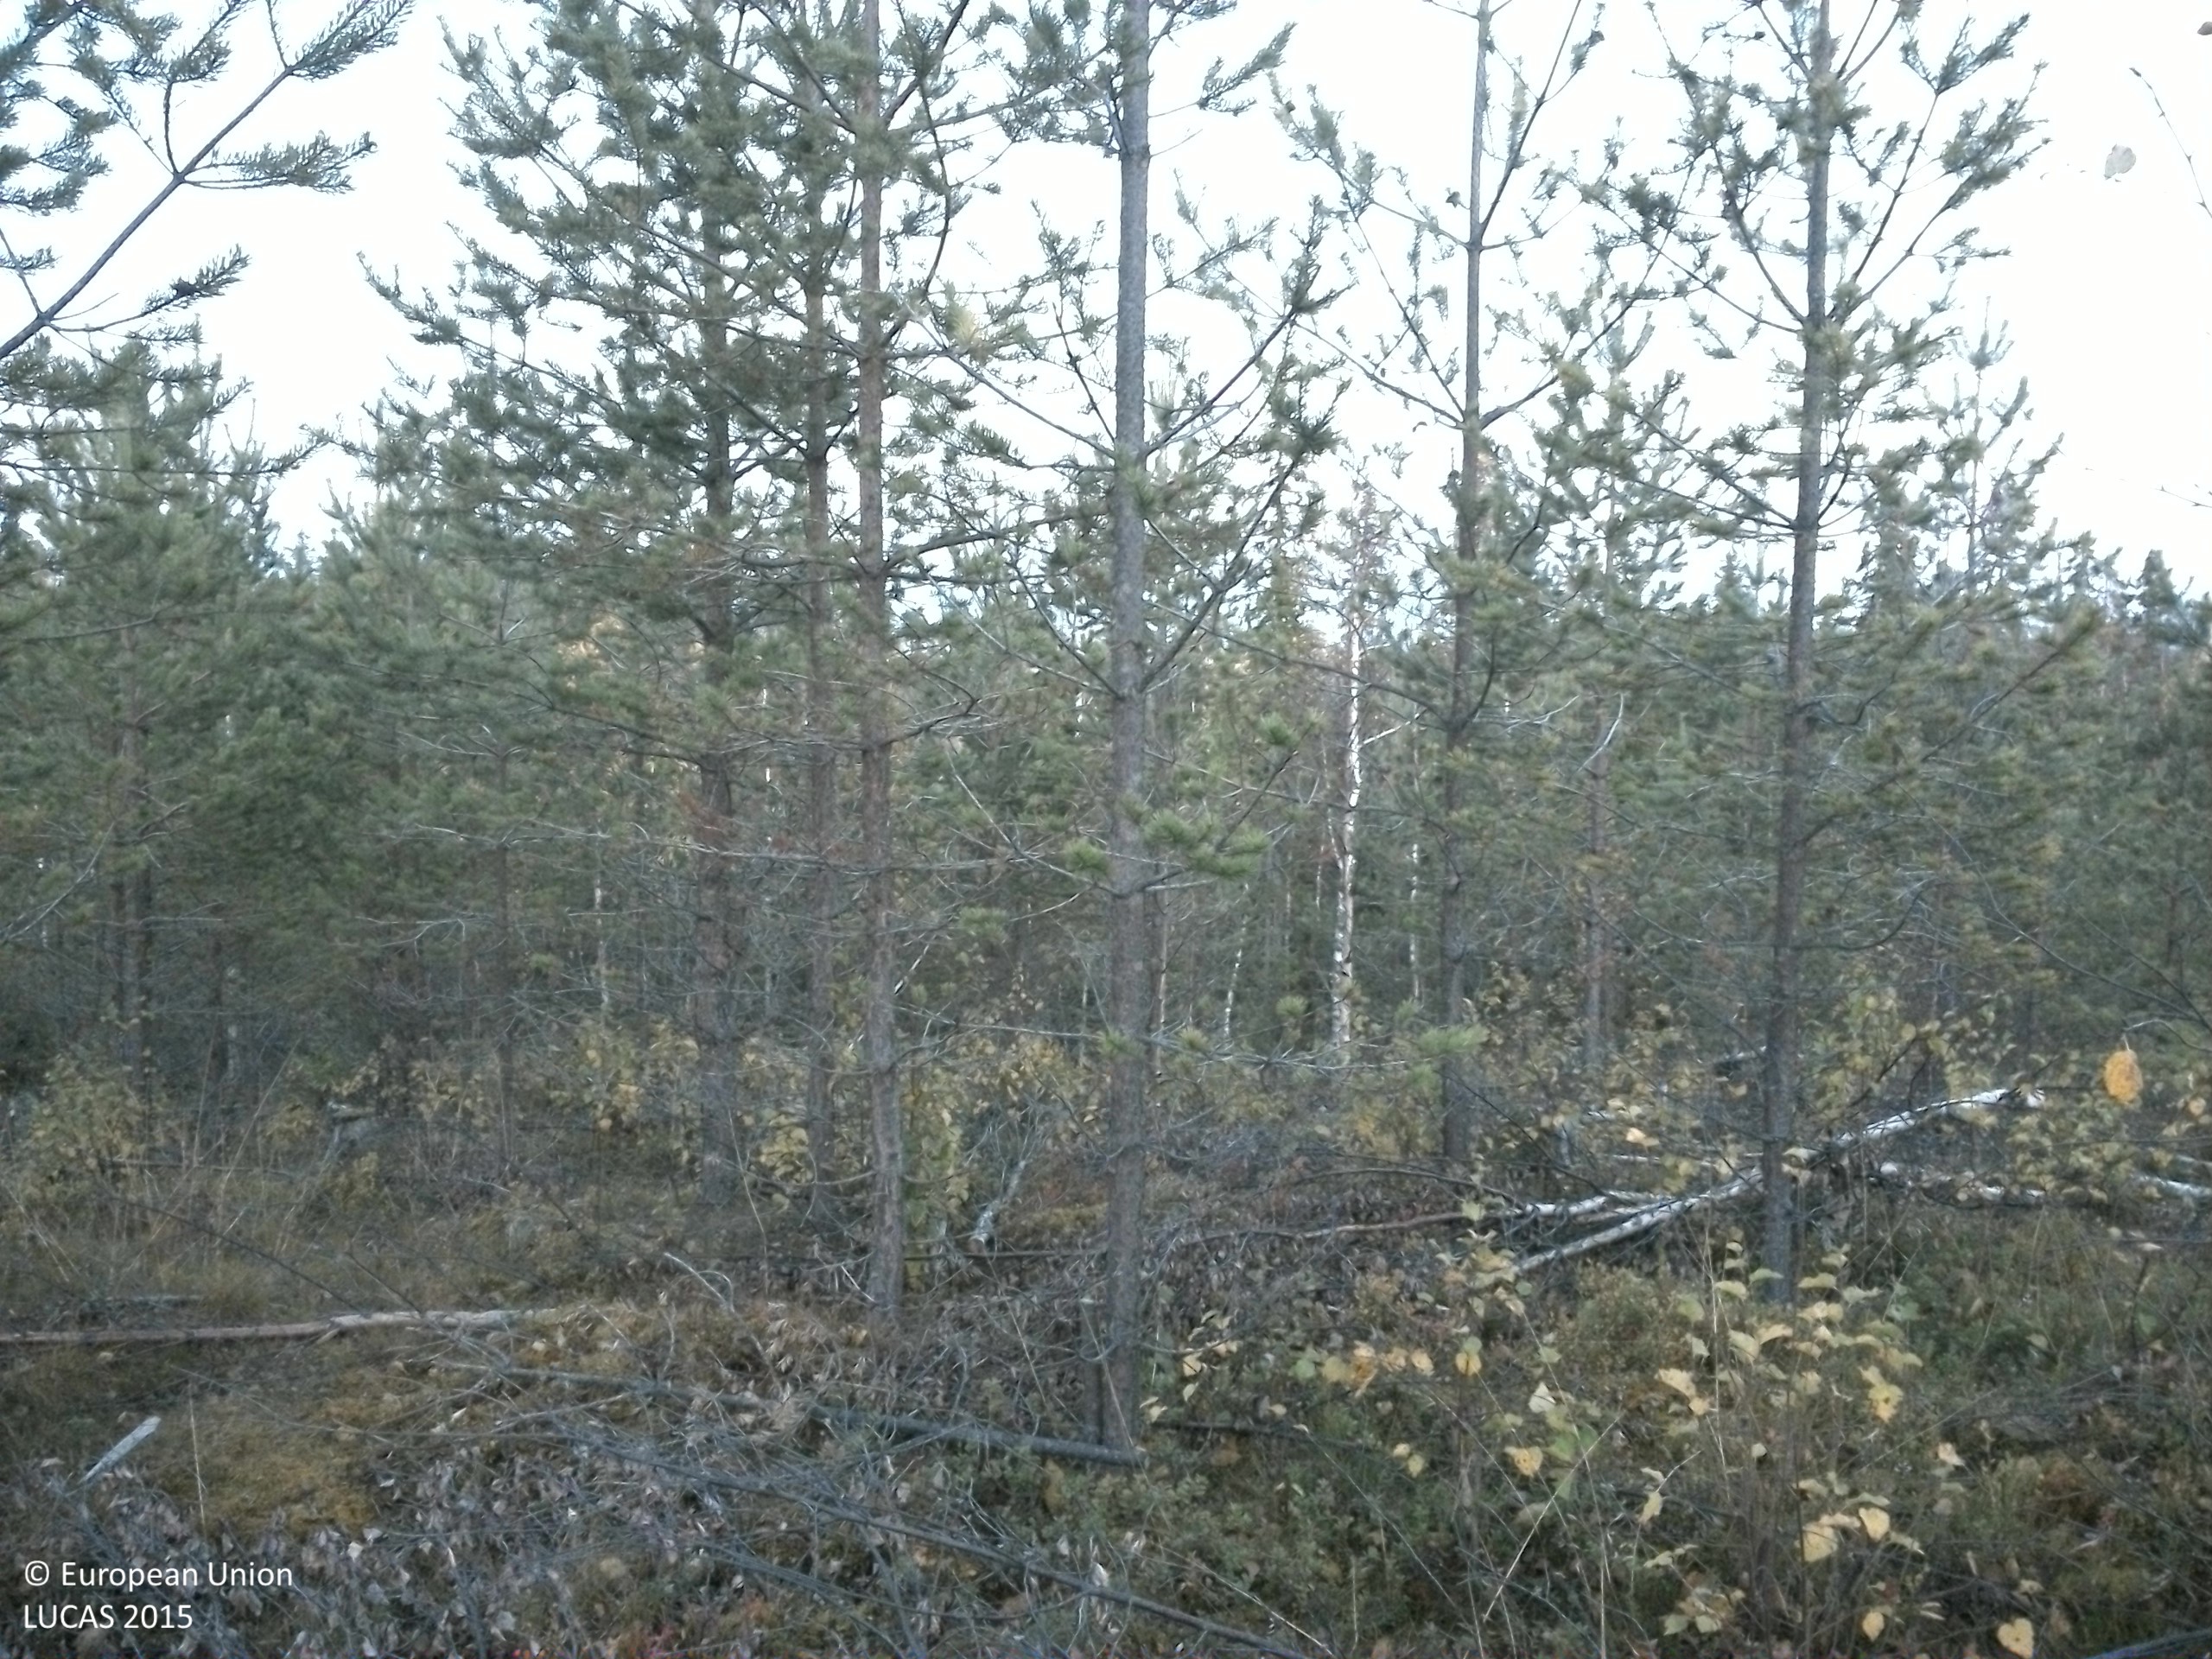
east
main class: Woodland
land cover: Pine dominated coniferous woodland
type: boreal forest
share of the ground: 25 - 50 %
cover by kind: coniferous forest trees 35 %, shrubs 30 %, lichens and mosses 15 %, broadleaved forest trees 10 %, herbaceous plants 10 %
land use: Forestry
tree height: < 5 m
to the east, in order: Pine dominated coniferous woodland; Spruce dominated mixed woodland; Pine dominated coniferous woodland; Pine dominated mixed woodland; Rocks and stones; Pine dominated mixed woodland
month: October
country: SE
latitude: 64.3166
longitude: 16.1116
